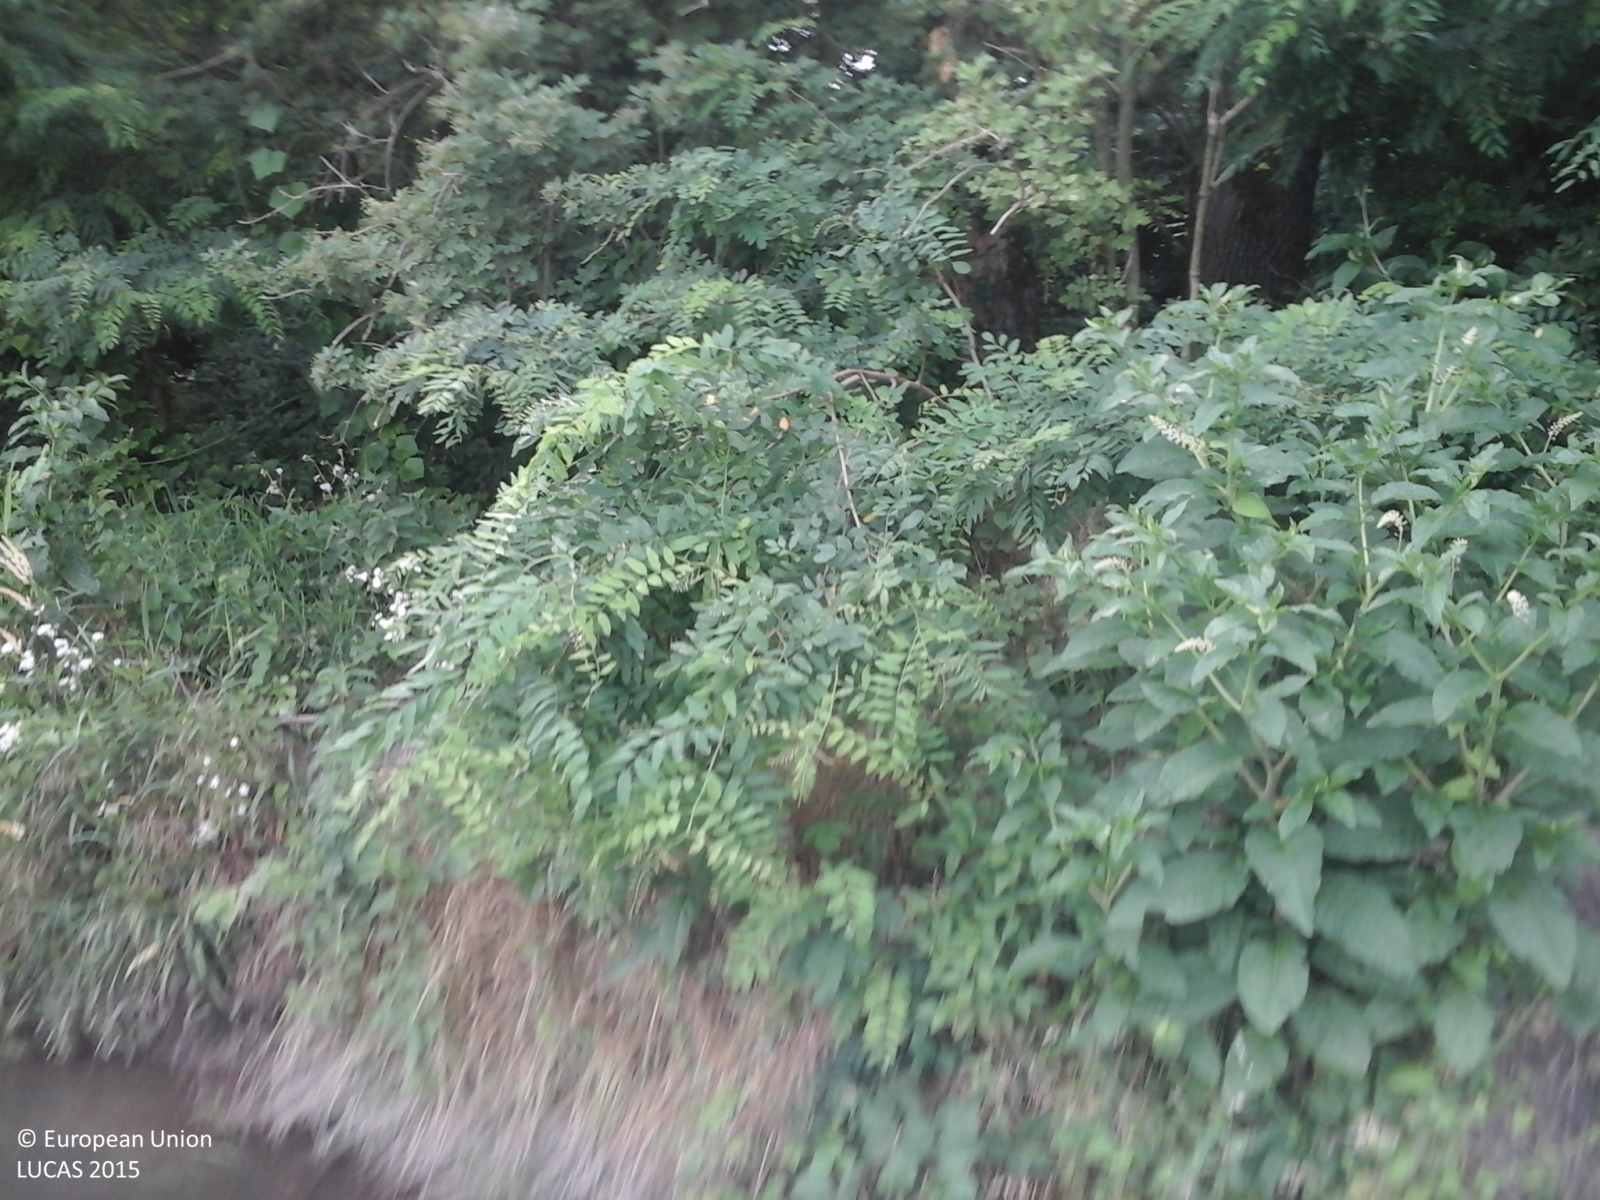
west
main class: Woodland
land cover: Broadleaved woodland
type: thermophilous deciduous forest
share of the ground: > 75 %
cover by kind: broadleaved forest trees 100 %
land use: Forestry
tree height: > 5 m
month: June
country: IT
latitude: 45.1911
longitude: 8.7930
